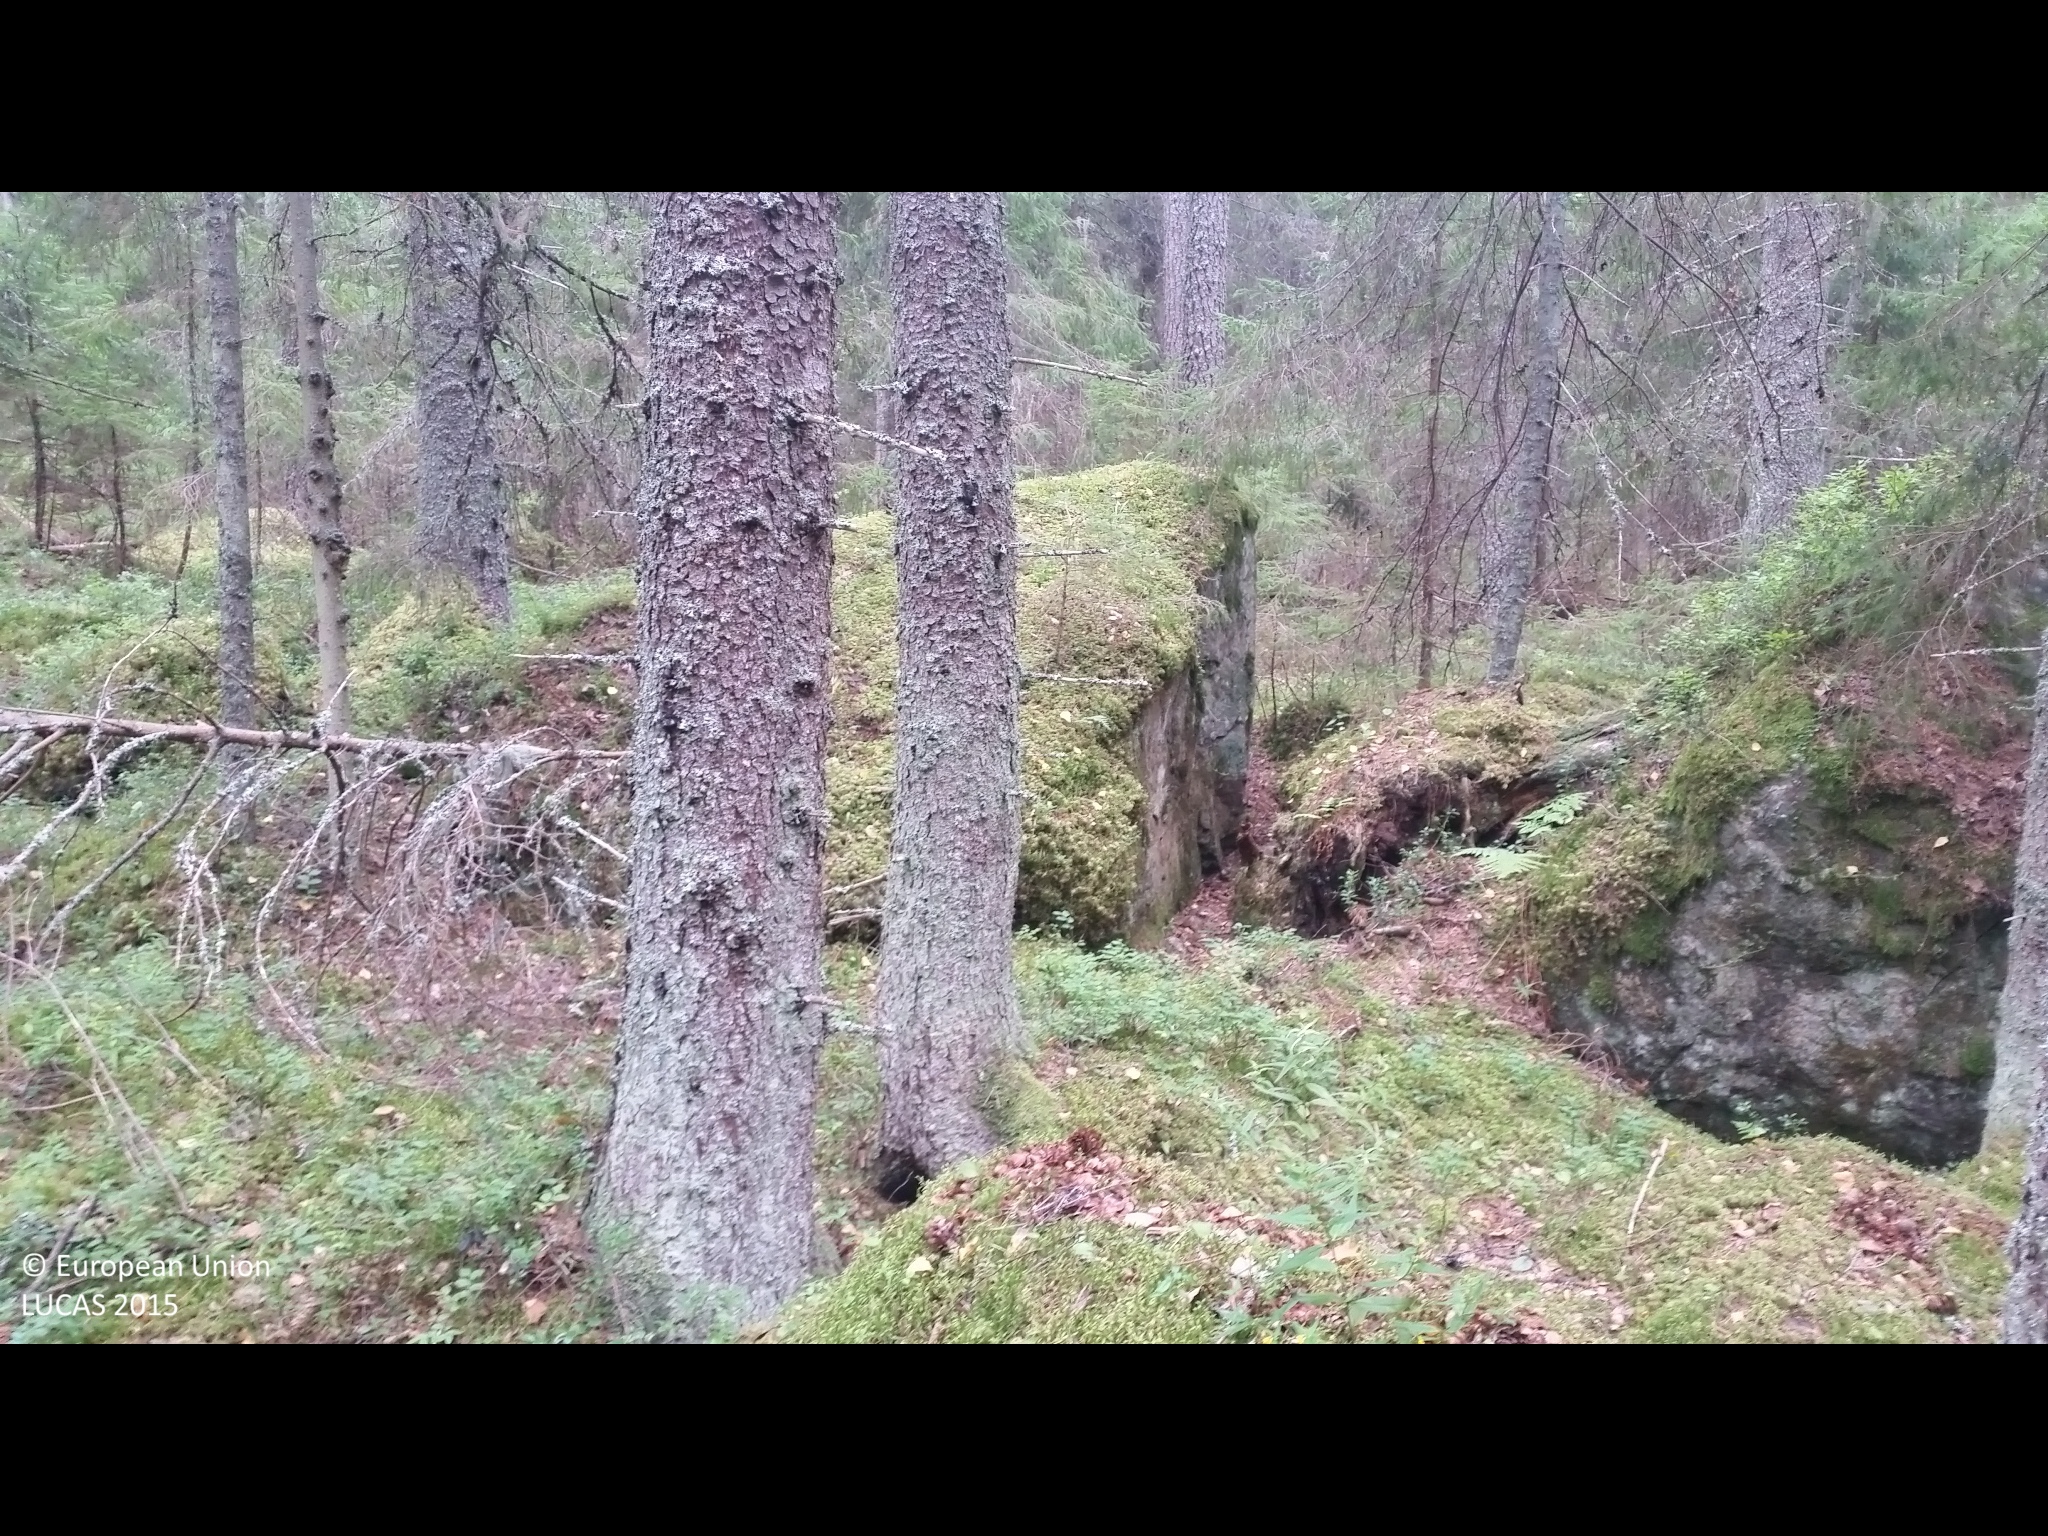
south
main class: Woodland
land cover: Spruce dominated coniferous woodland
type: boreal forest
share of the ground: > 75 %
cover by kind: coniferous forest trees 75 %, lichens and mosses 10 %, shrubs 5 %, herbaceous plants 5 %, consolidated bare surface 5 %
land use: Forestry
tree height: > 5 m
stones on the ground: < 10 %
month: August
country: SE
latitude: 60.8620
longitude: 17.2608
